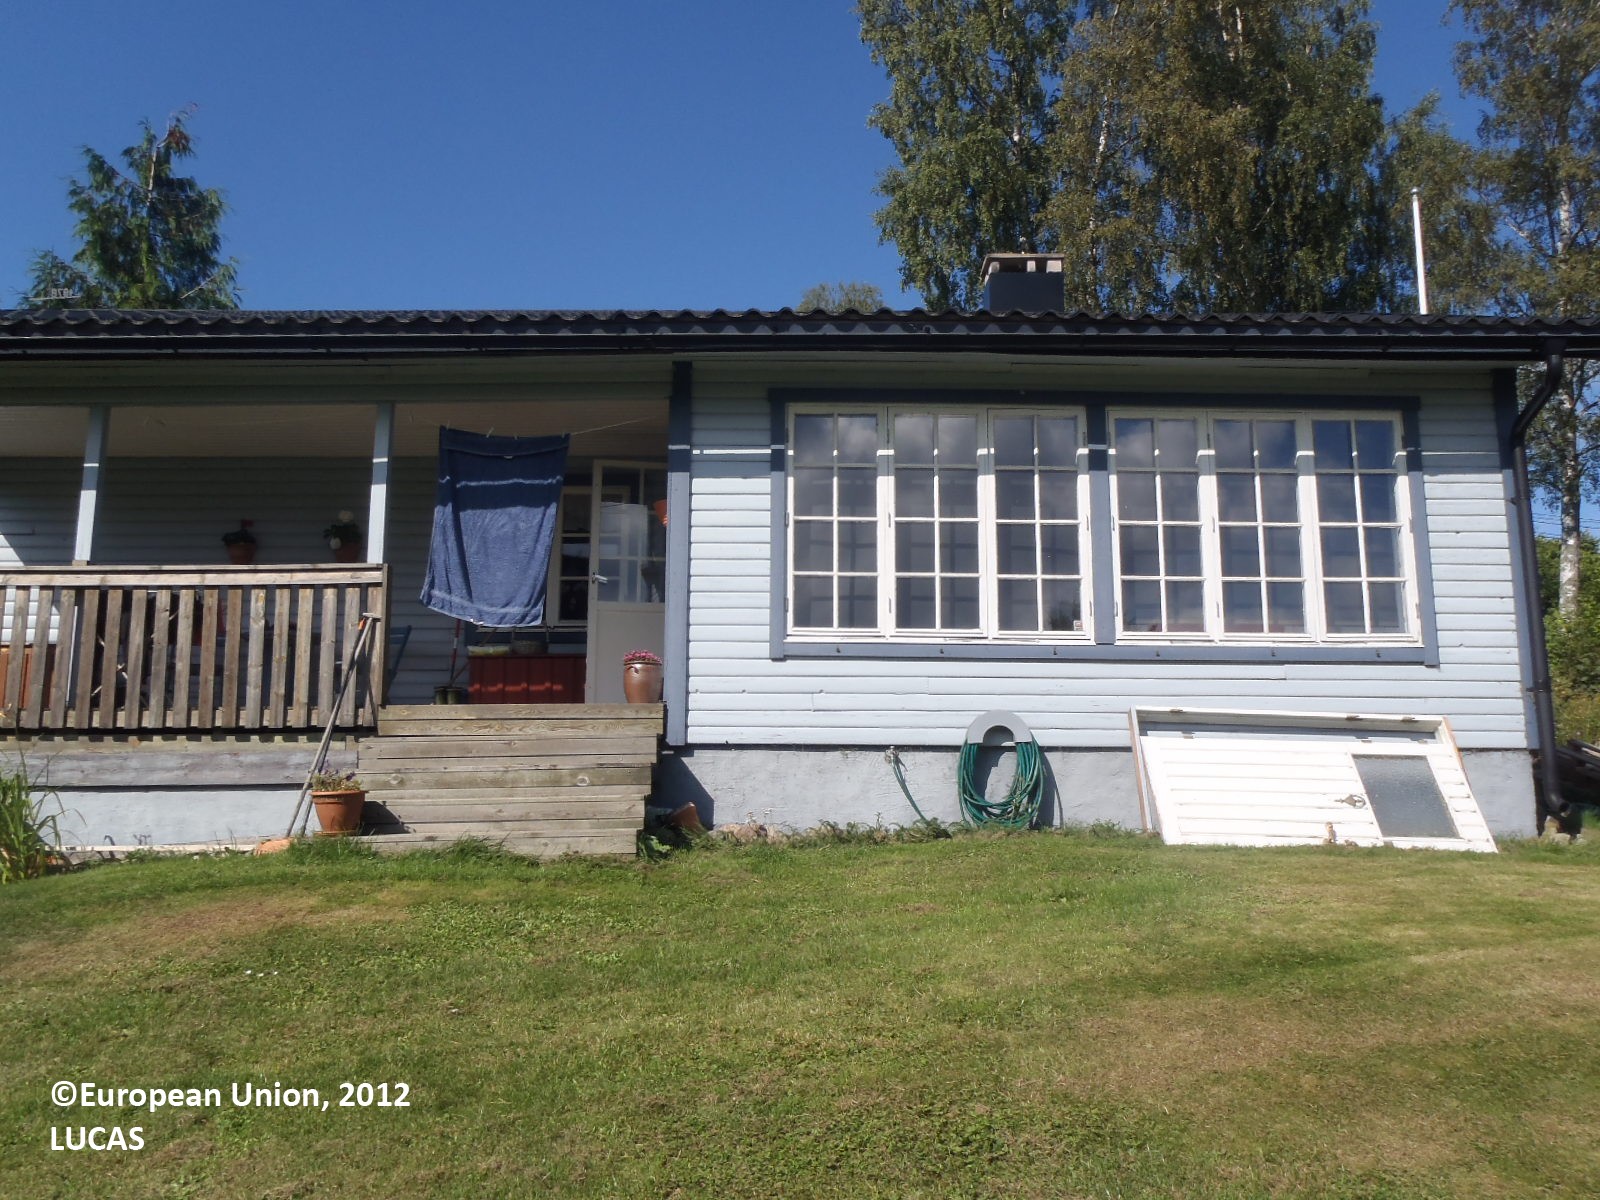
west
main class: Grassland
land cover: Grassland without tree/shrub cover
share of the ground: > 75 %
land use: Residential
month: August
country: FI
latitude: 60.1030
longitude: 19.9170
